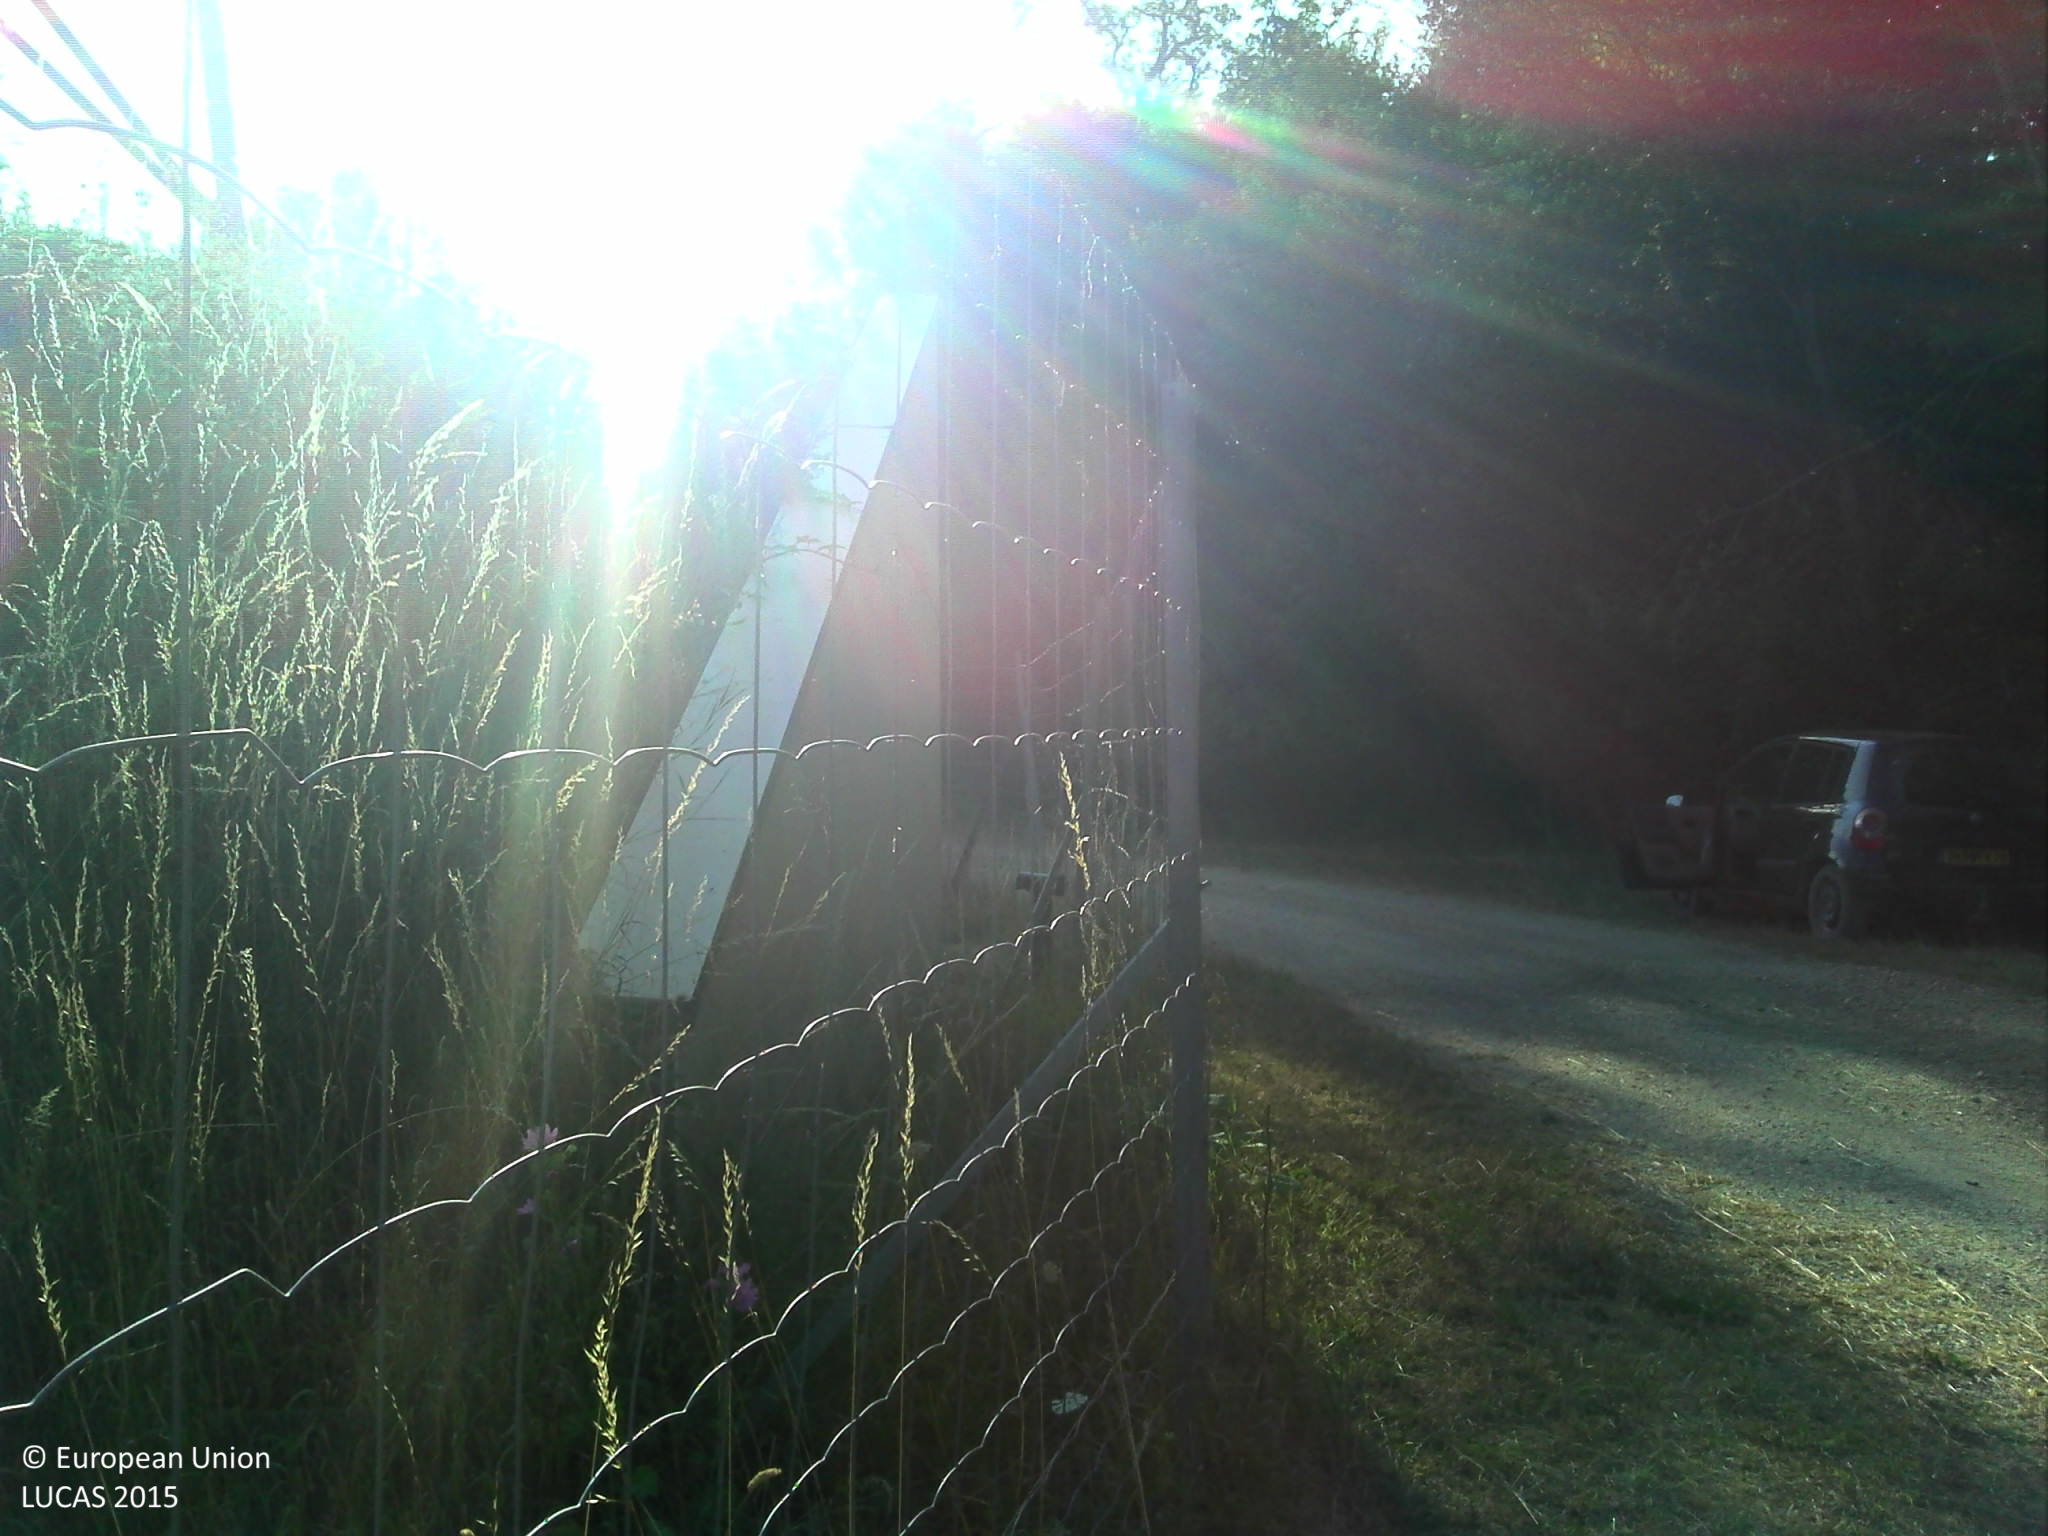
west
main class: Grassland
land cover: Grassland without tree/shrub cover
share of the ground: > 75 %
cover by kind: herbaceous plants 100 %
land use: Telecommunication
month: July
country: FR
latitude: 48.0391
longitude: 5.0230
